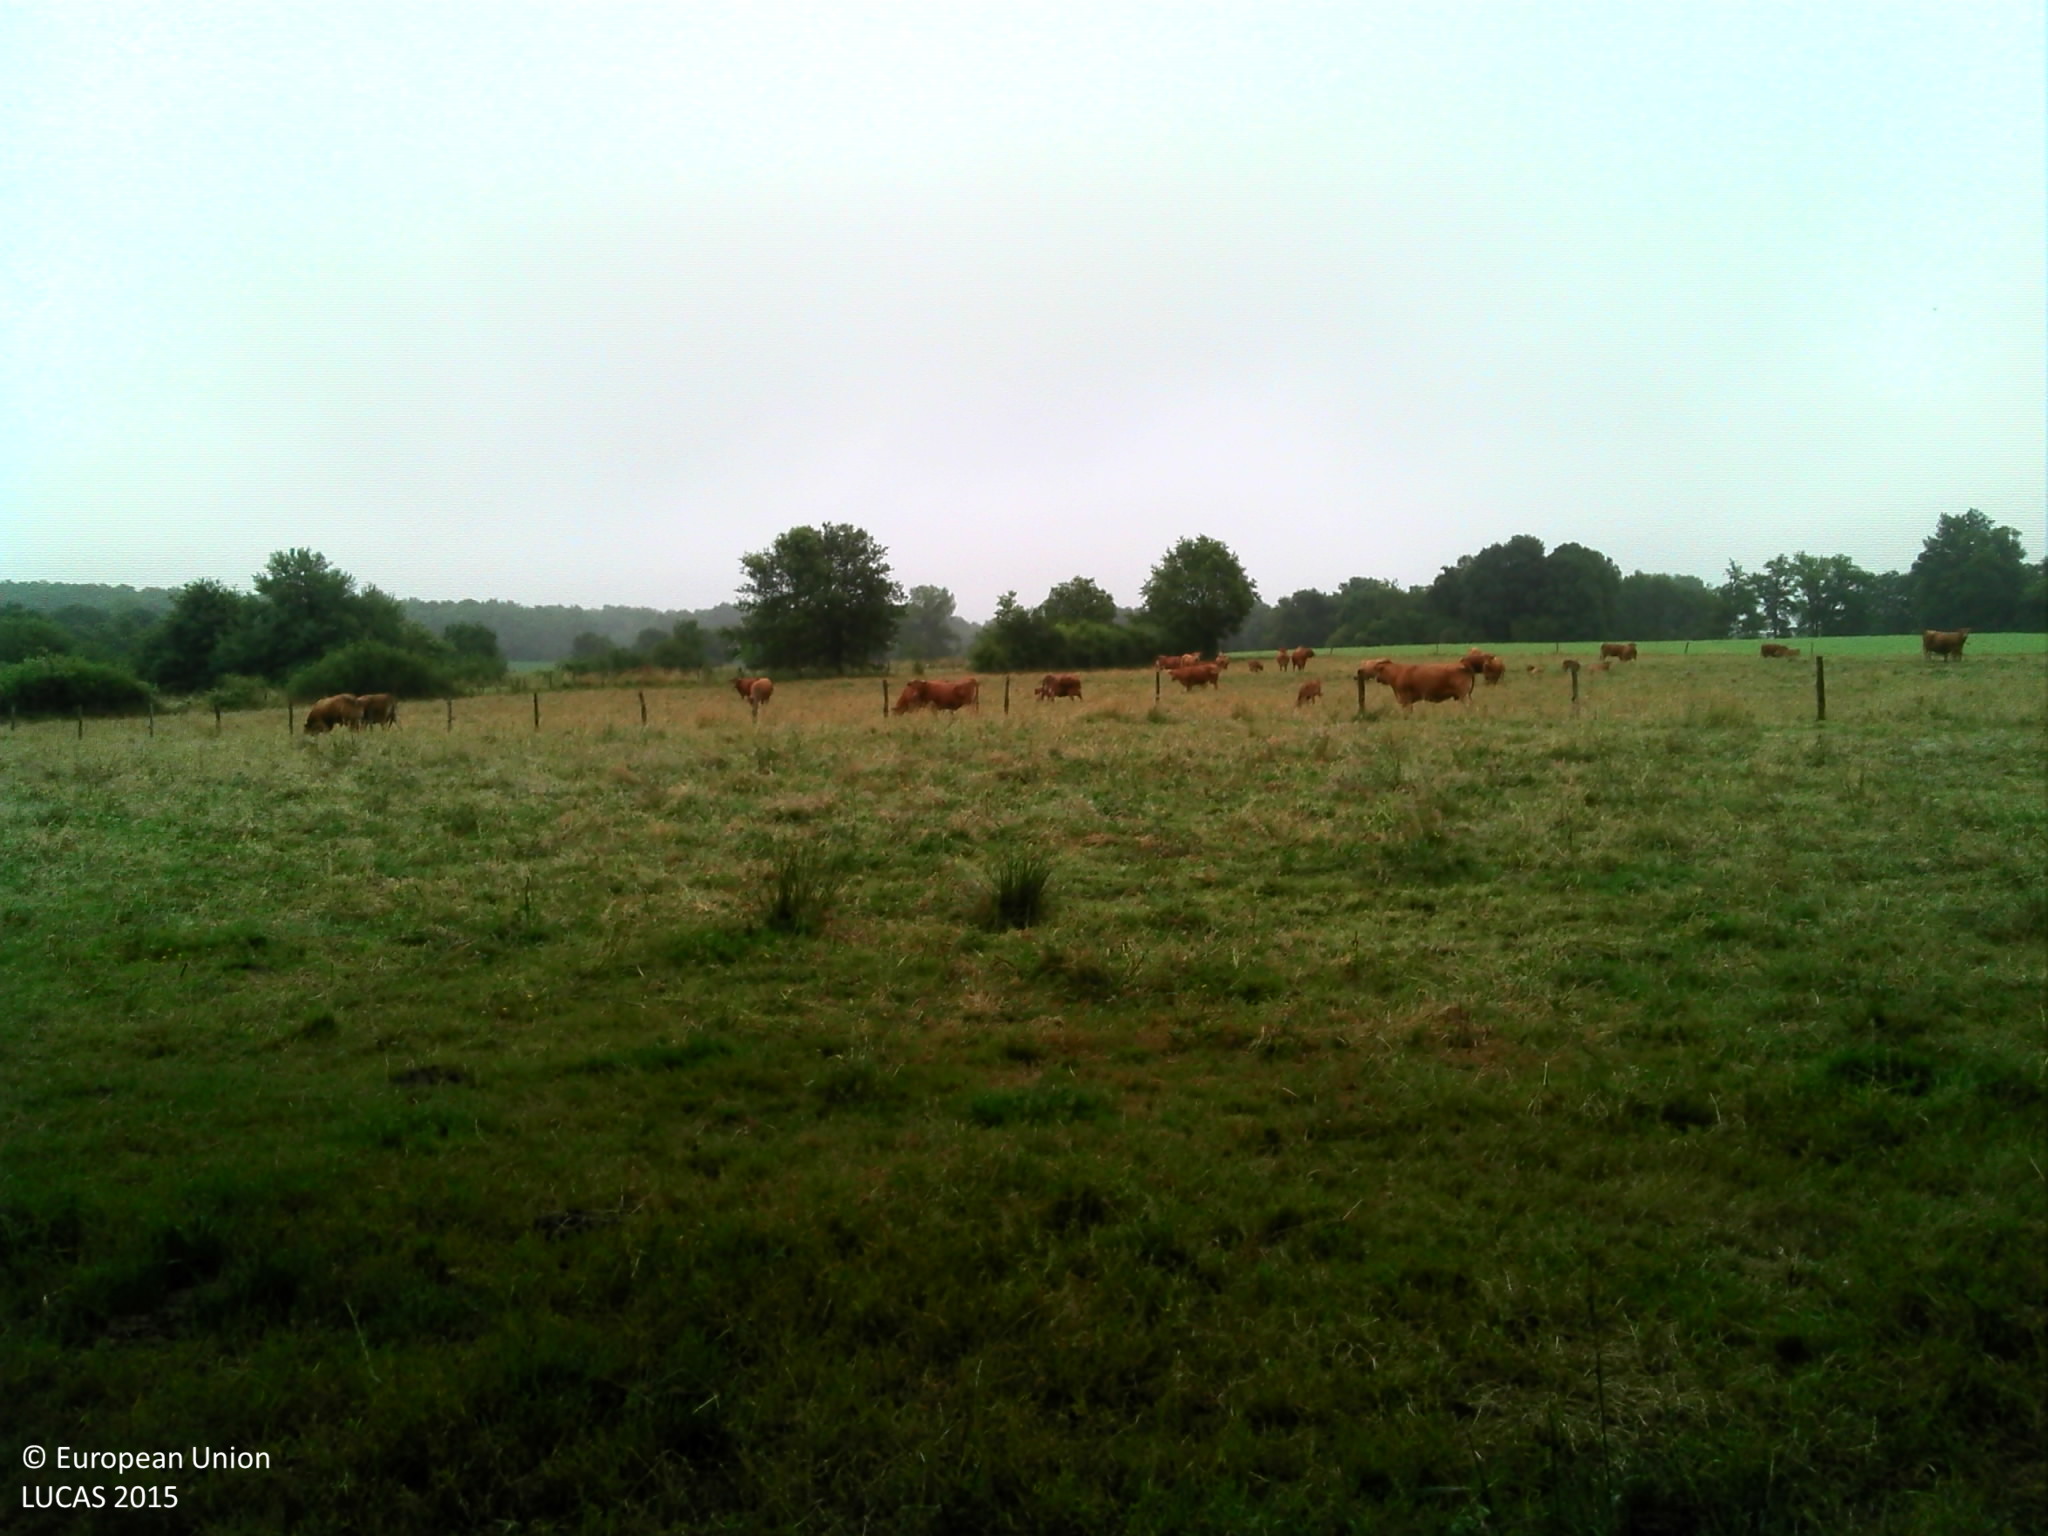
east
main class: Grassland
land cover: Grassland with sparse tree/shrub cover
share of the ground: > 75 %
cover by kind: herbaceous plants 95 %, coniferous forest trees 5 %
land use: Agriculture (excluding fallow land and kitchen gardens)
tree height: > 5 m
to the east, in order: Grassland with sparse tree/shrub cover; Fences; Grassland without tree/shrub cover; Fences; Grassland without tree/shrub cover; Fences; Grassland without tree/shrub cover
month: June
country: FR
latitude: 45.7899
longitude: 0.5828
